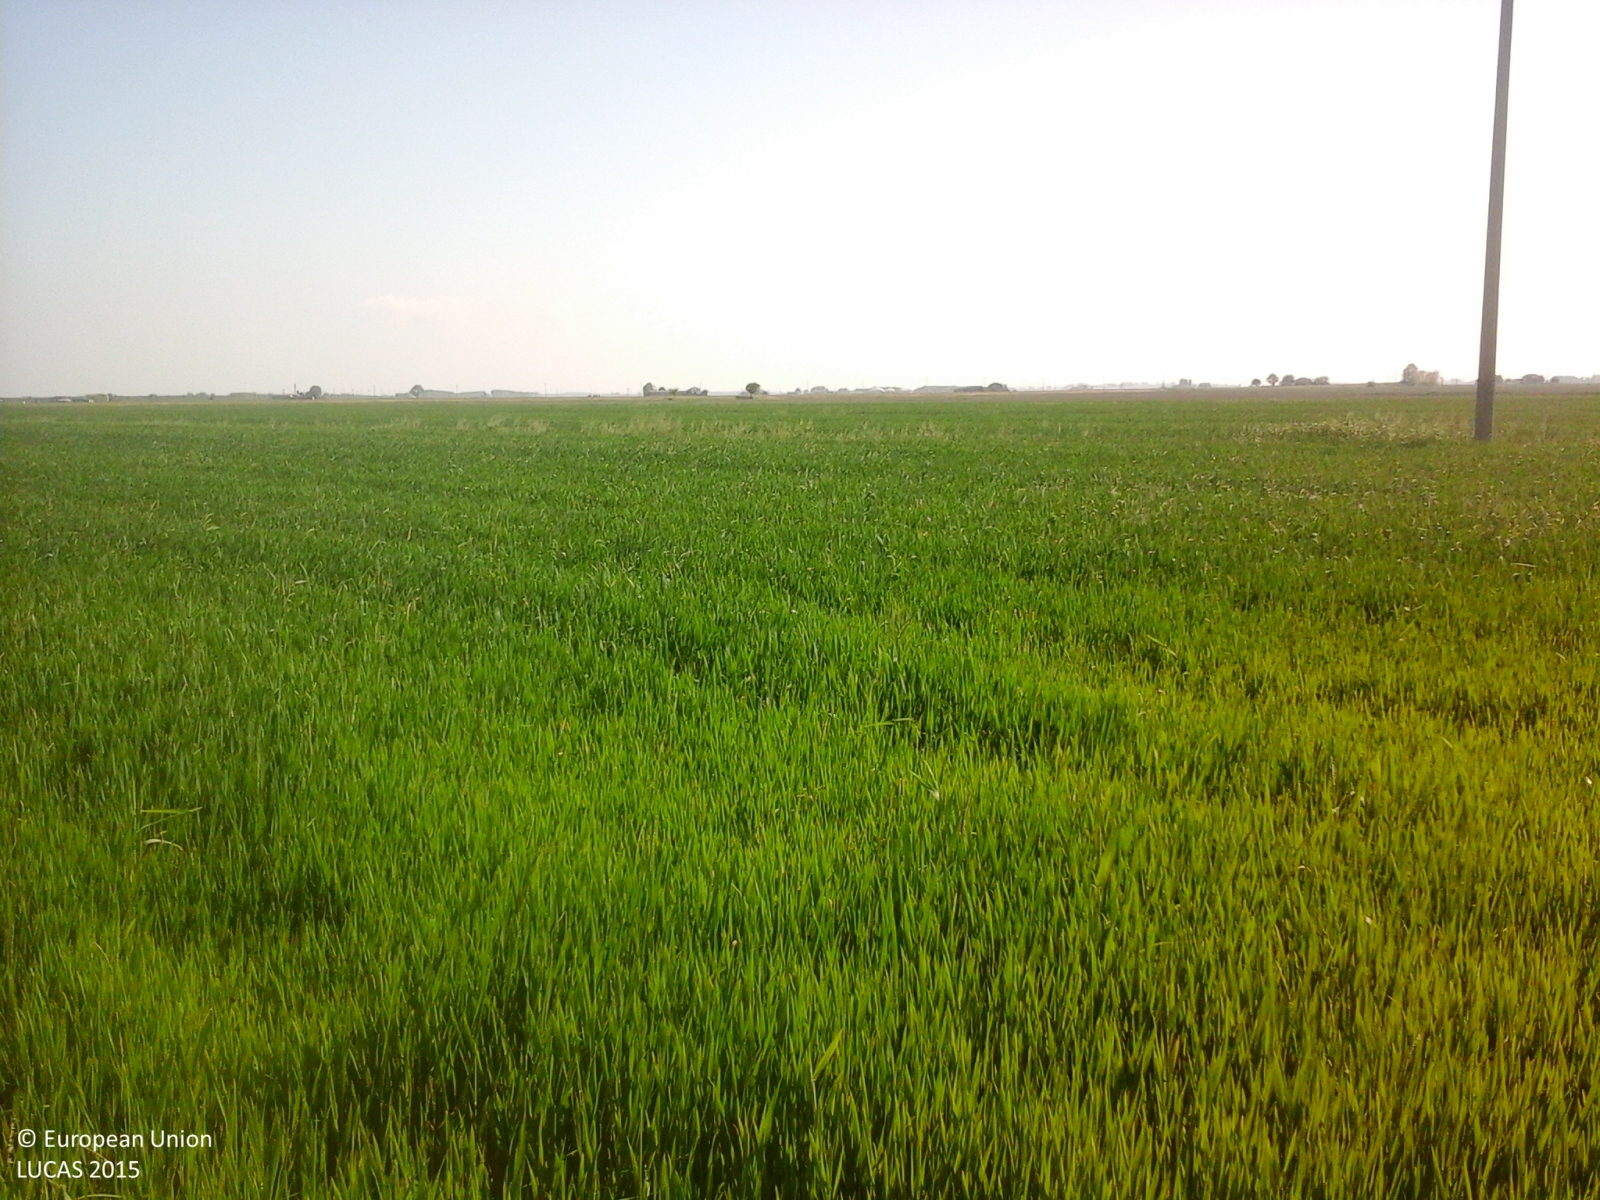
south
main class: Cropland
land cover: Common wheat
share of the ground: > 75 %
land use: Agriculture (excluding fallow land and kitchen gardens)
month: April
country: IT
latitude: 45.0287
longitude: 12.2932
